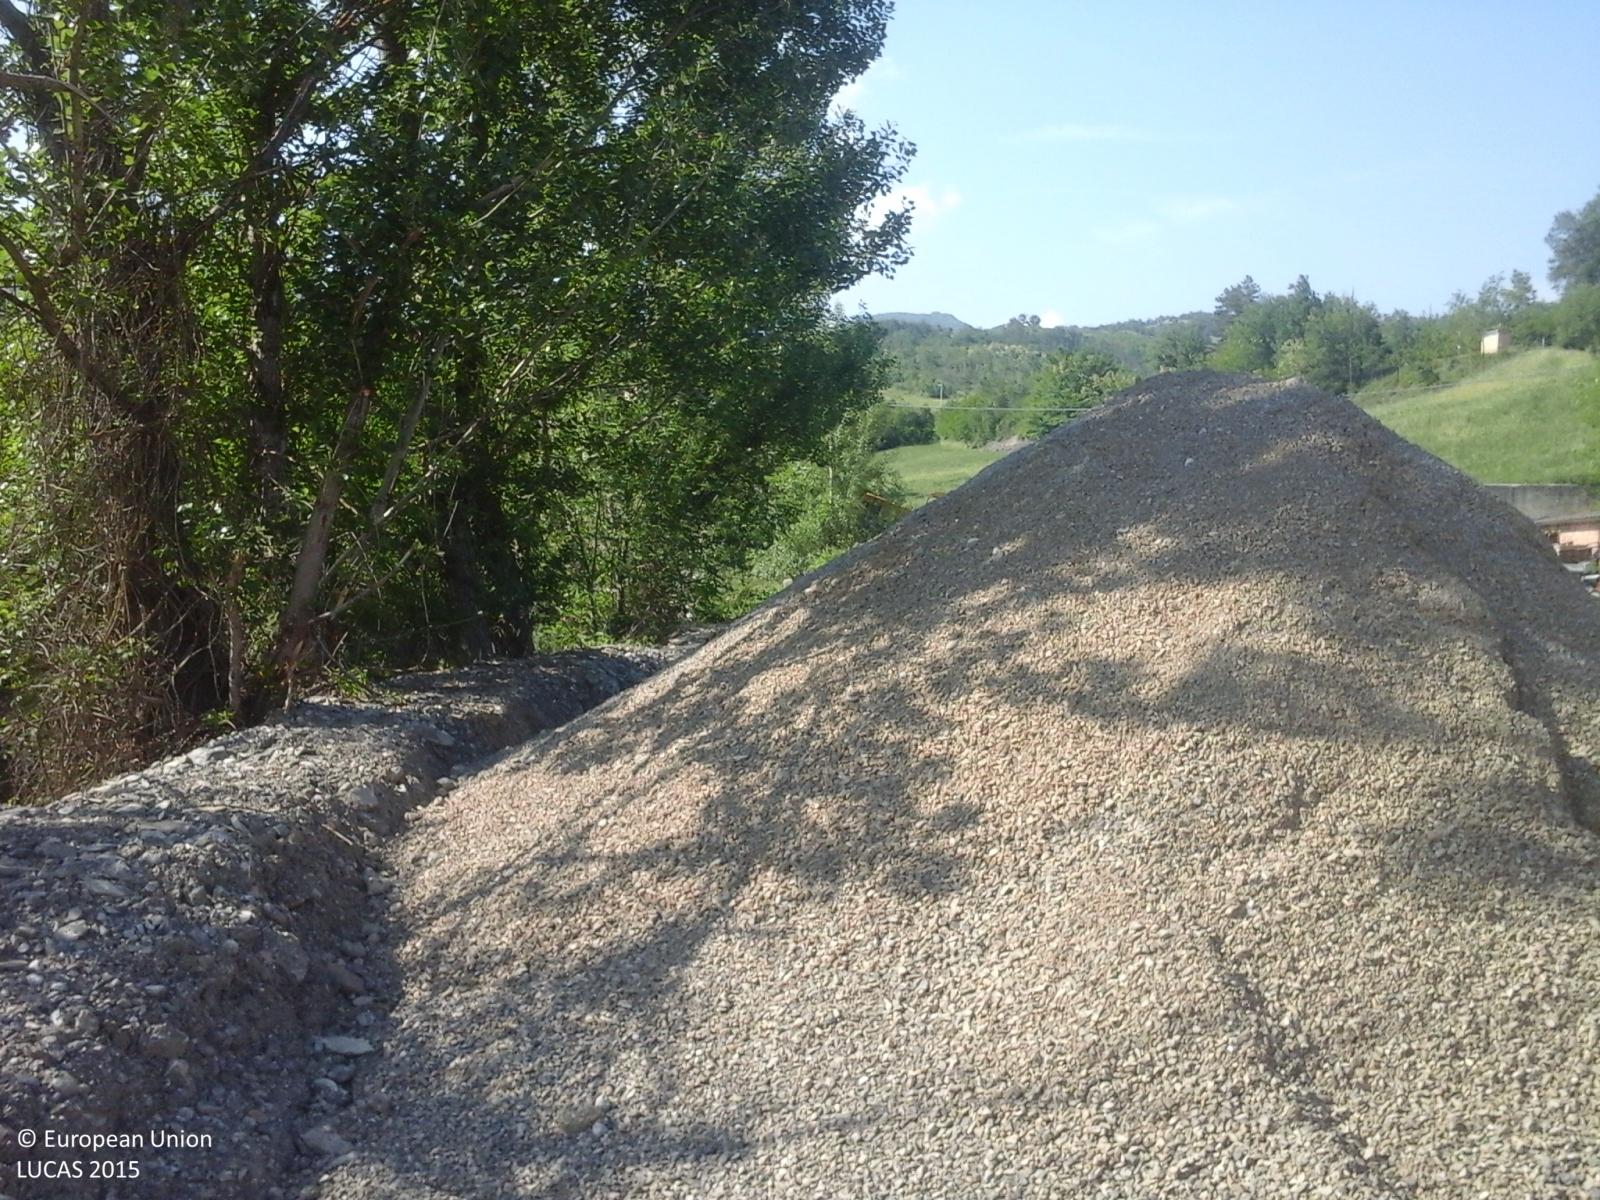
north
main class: Woodland
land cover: Broadleaved woodland
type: thermophilous deciduous forest
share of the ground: > 75 %
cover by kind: broadleaved forest trees 100 %
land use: Forestry
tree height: > 5 m
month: May
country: IT
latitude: 44.1838
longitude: 10.9609
